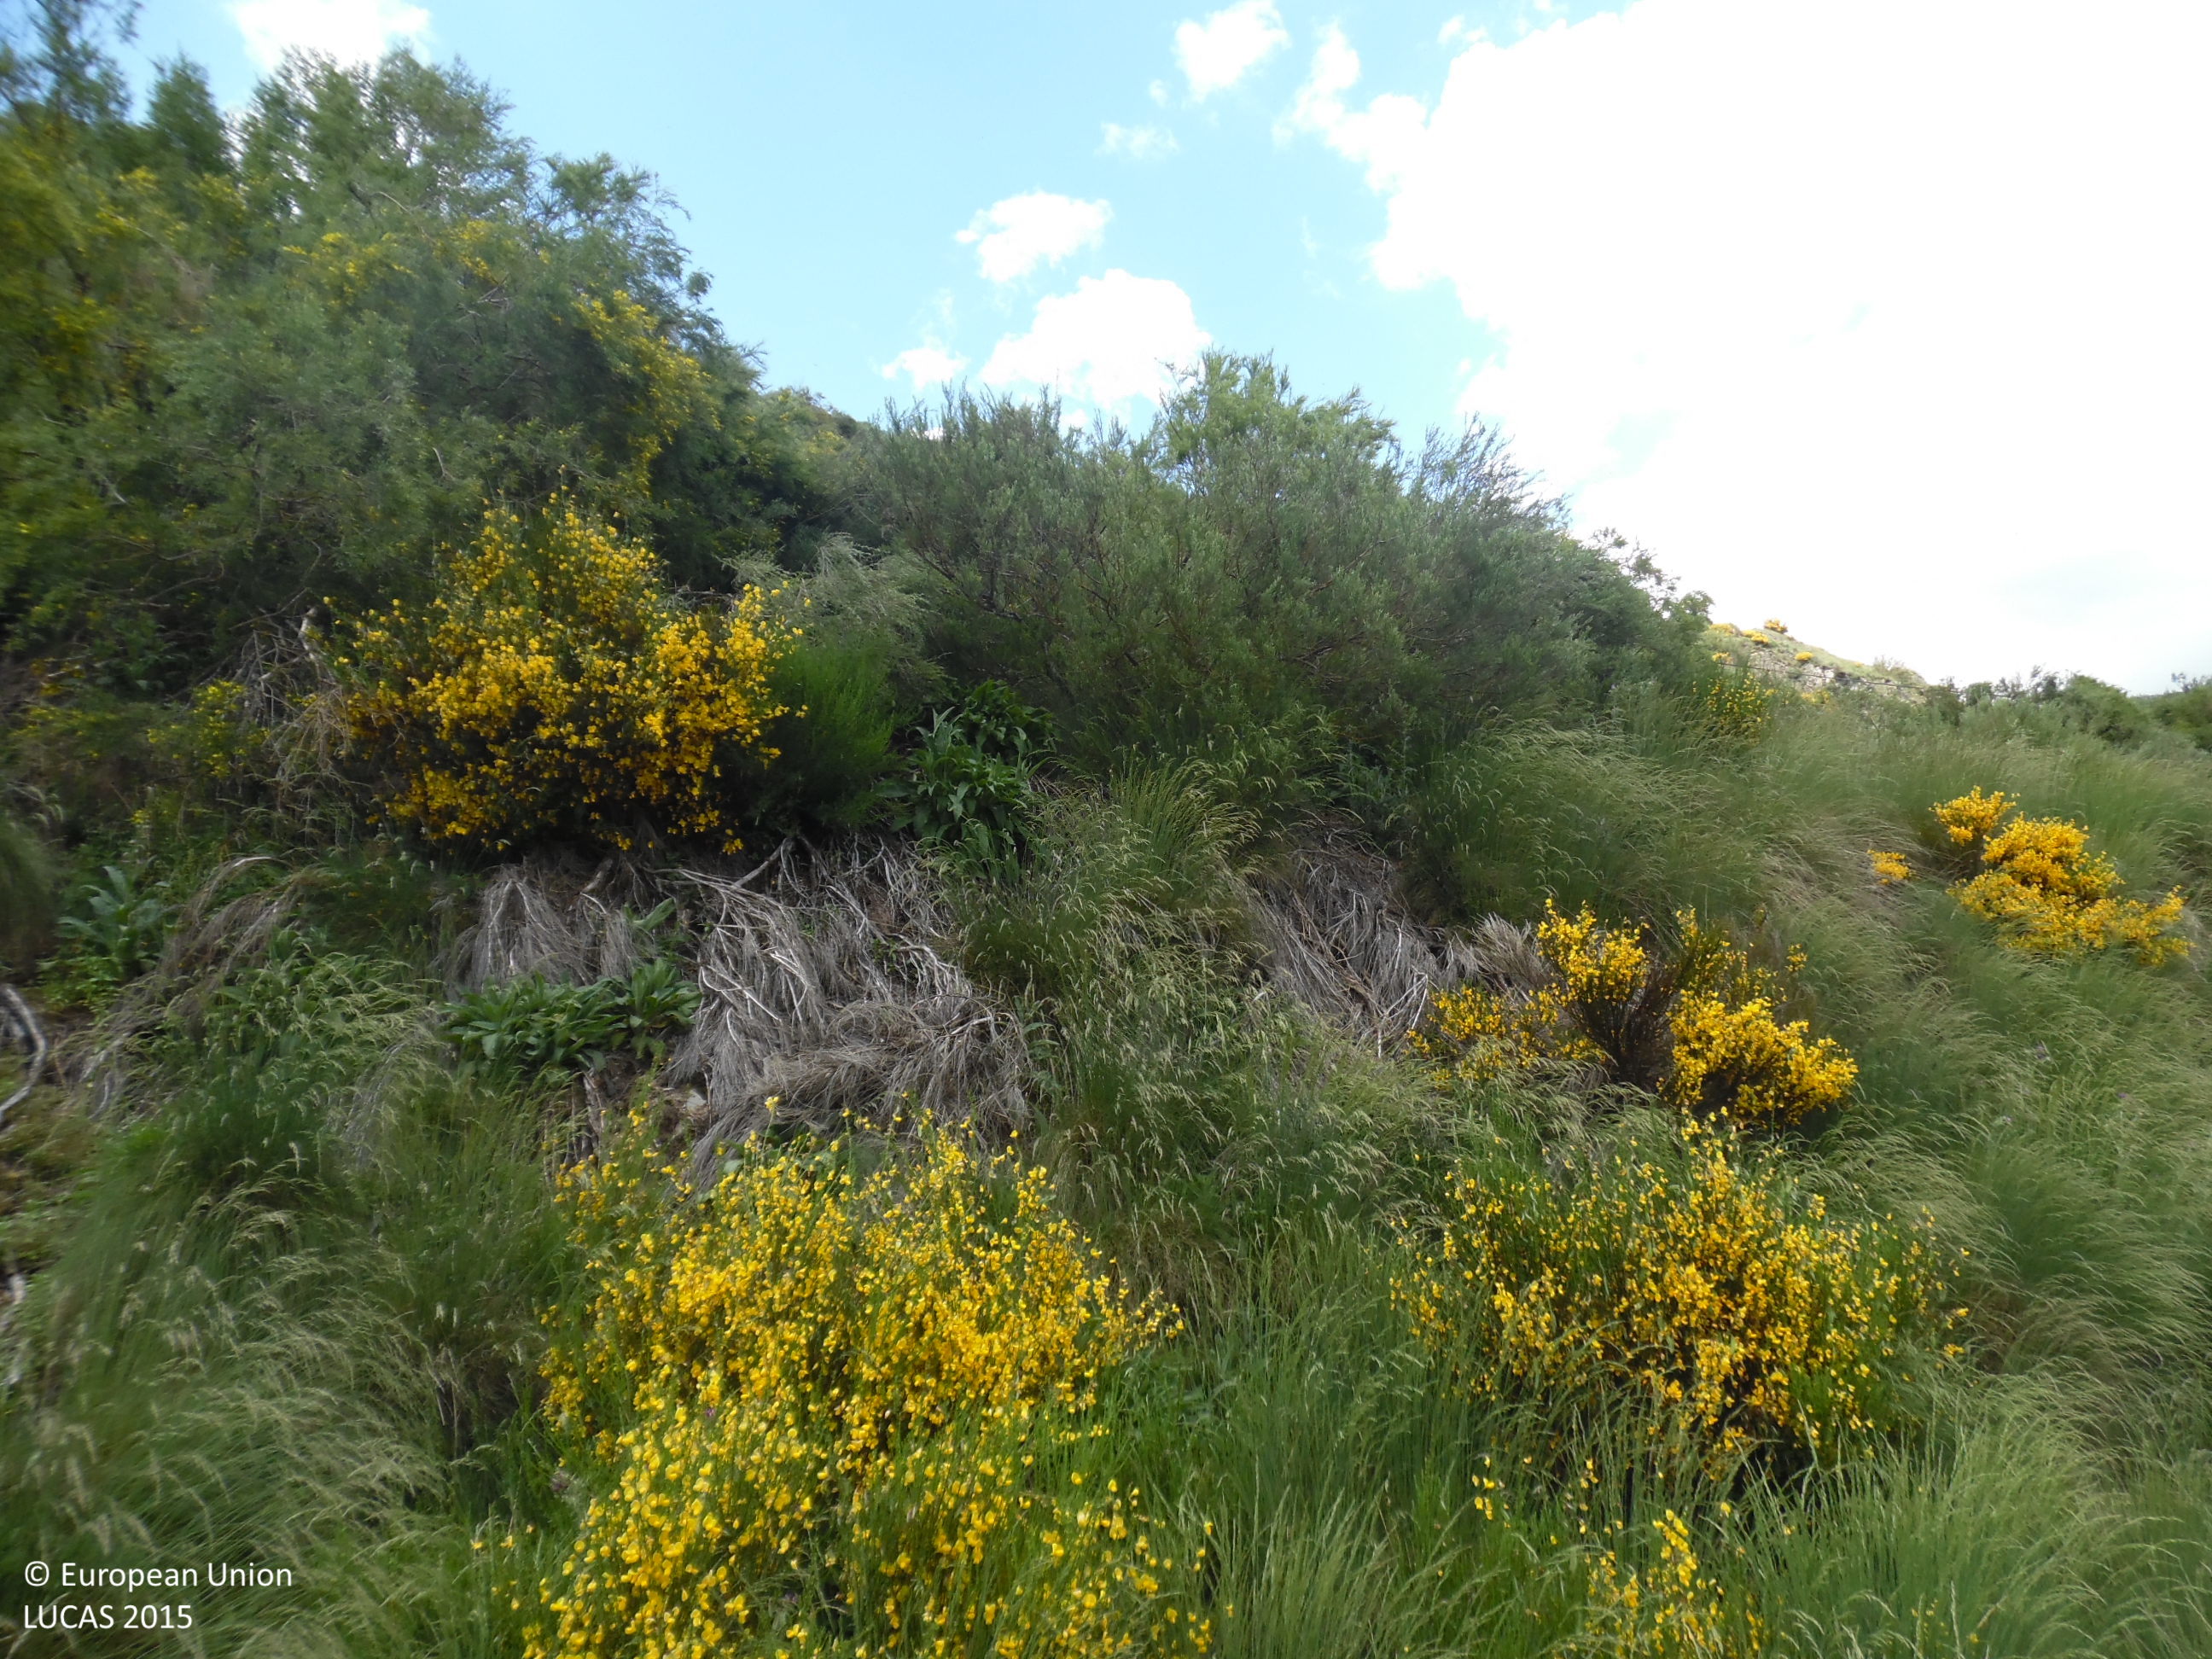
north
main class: Shrubland
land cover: Shrubland with sparse tree cover
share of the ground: 50 - 75 %
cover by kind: shrubs 85 %, herbaceous plants 10 %, coniferous forest trees 5 %
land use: Abandoned areas
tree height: < 5 m
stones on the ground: 10 - 25 %
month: May
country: ES
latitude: 42.8500
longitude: -6.1809
